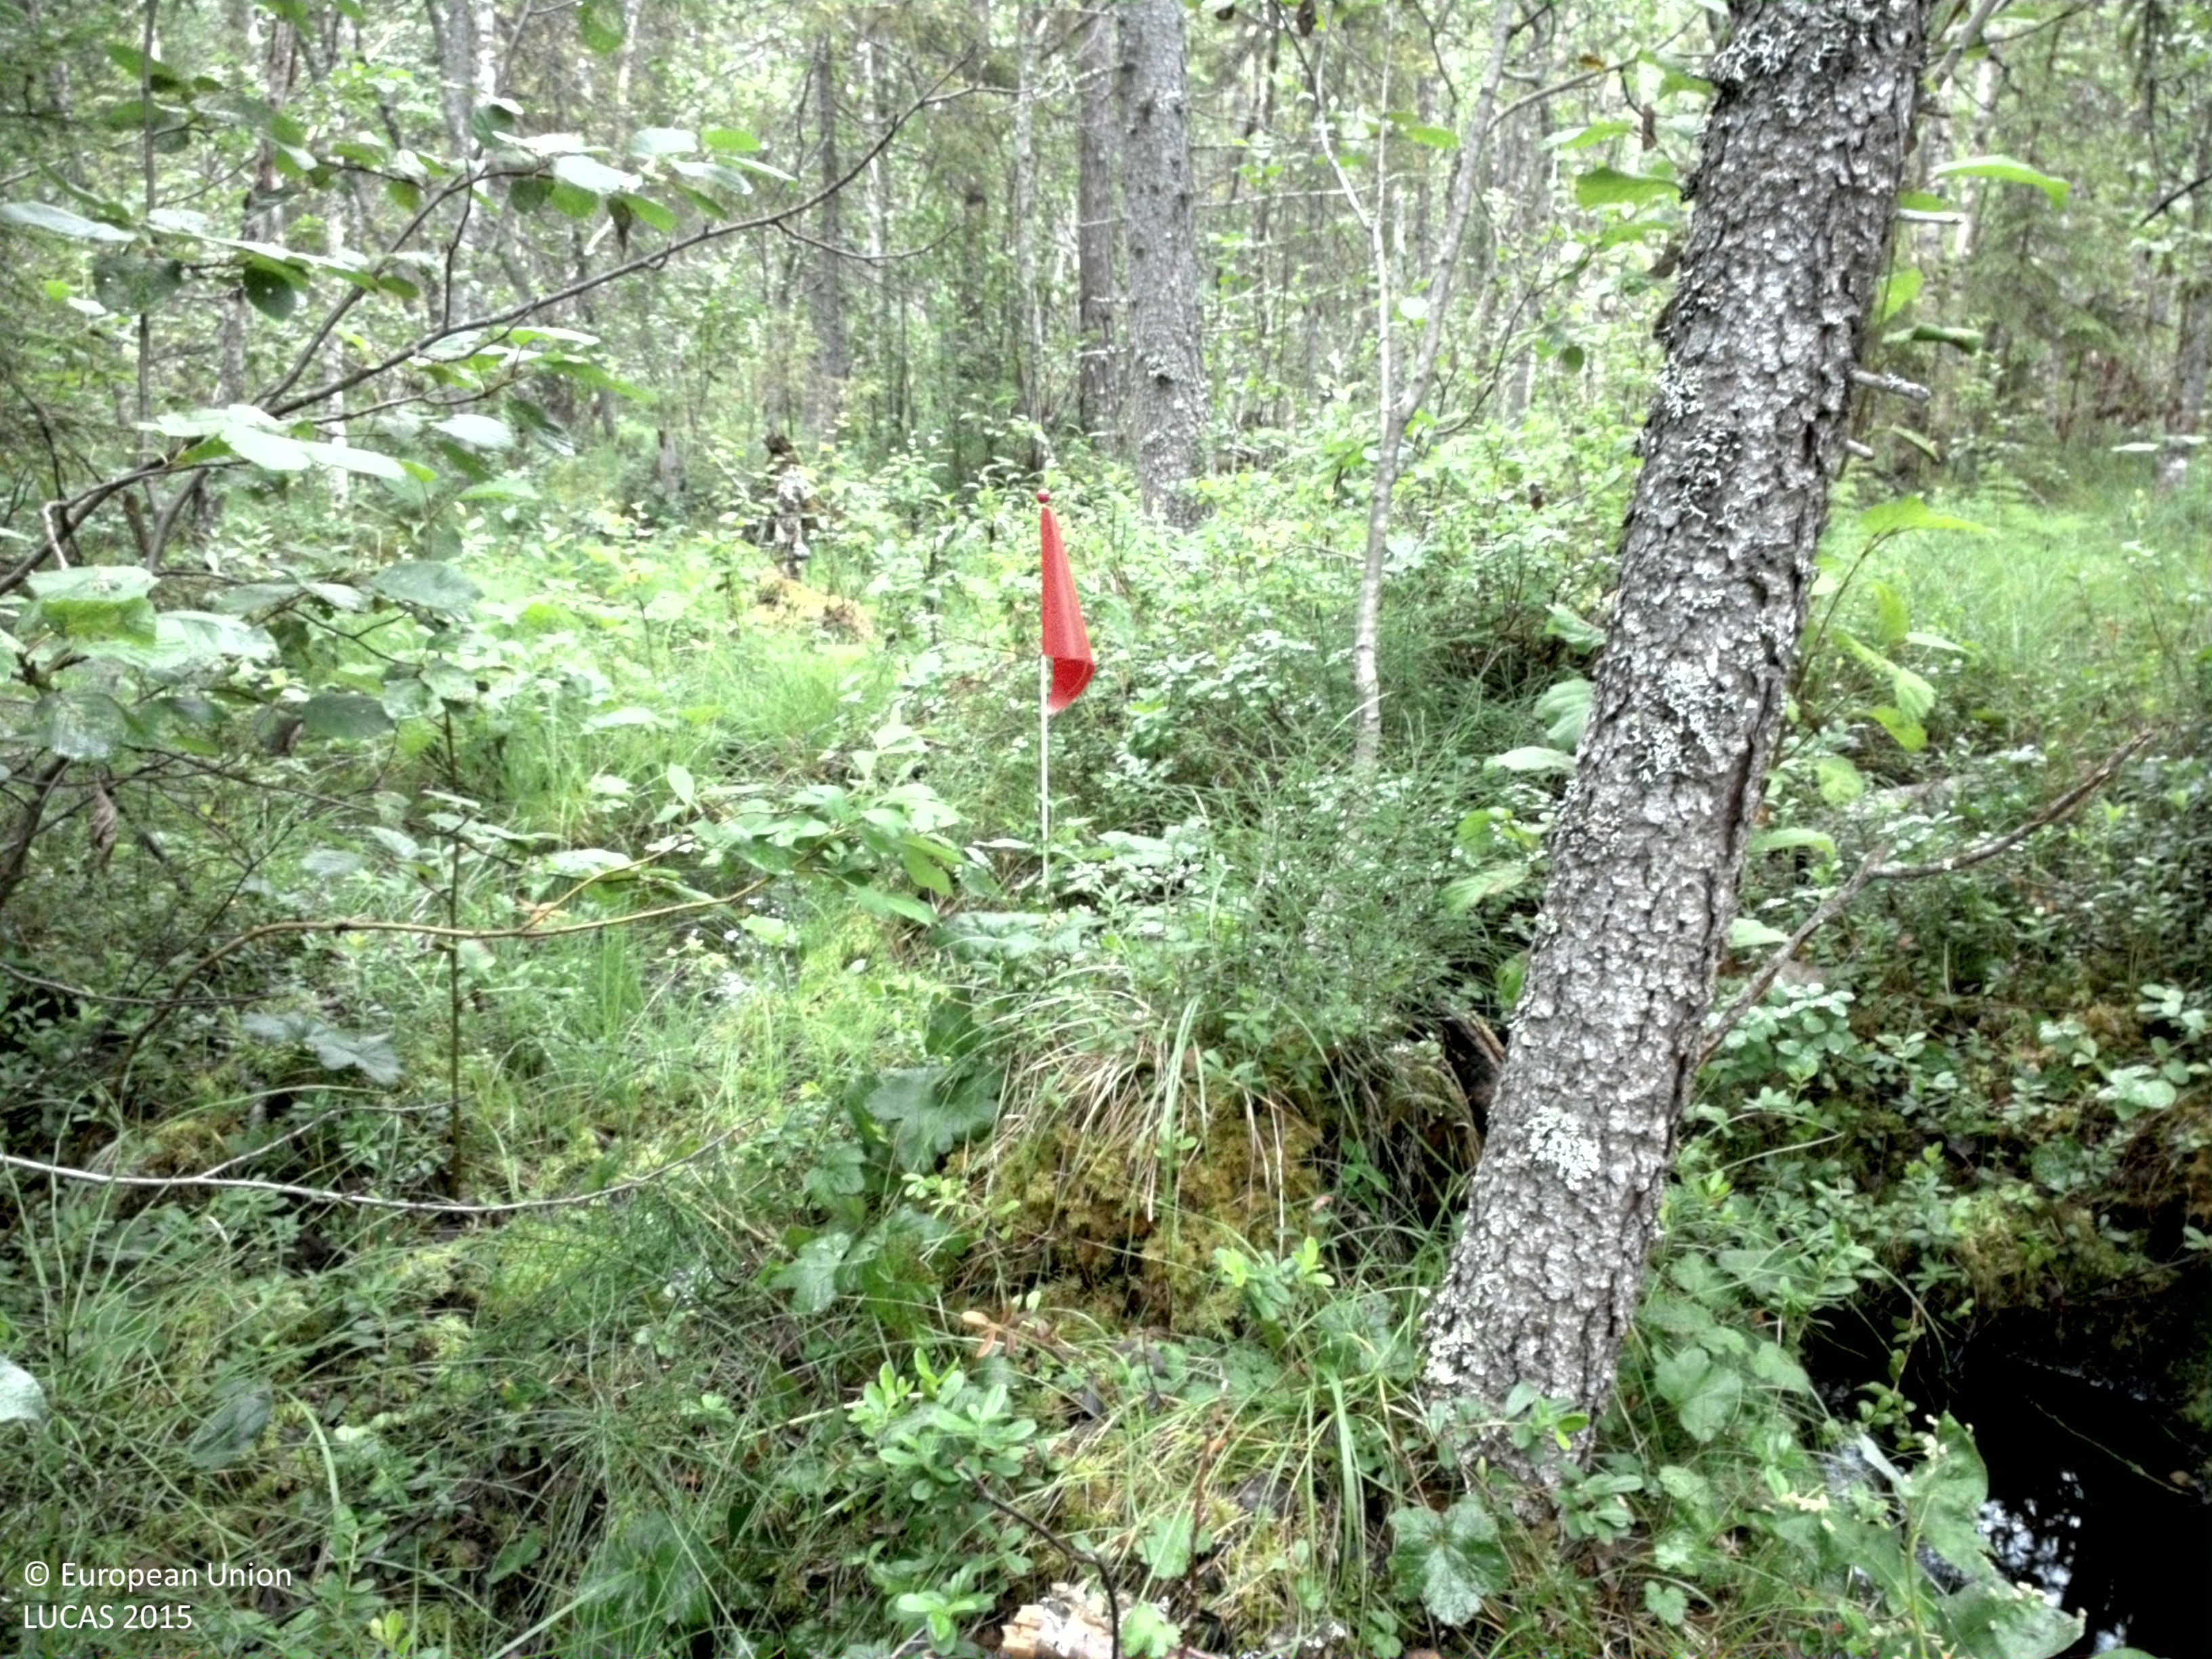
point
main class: Woodland
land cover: Broadleaved woodland
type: mire and swamp forests
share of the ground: 50 - 75 %
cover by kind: broadleaved forest trees 50 %, shrubs 30 %, coniferous forest trees 10 %
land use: Semi-natural and natural areas not in use
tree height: > 5 m
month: August
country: SE
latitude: 66.4948
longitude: 20.5395
